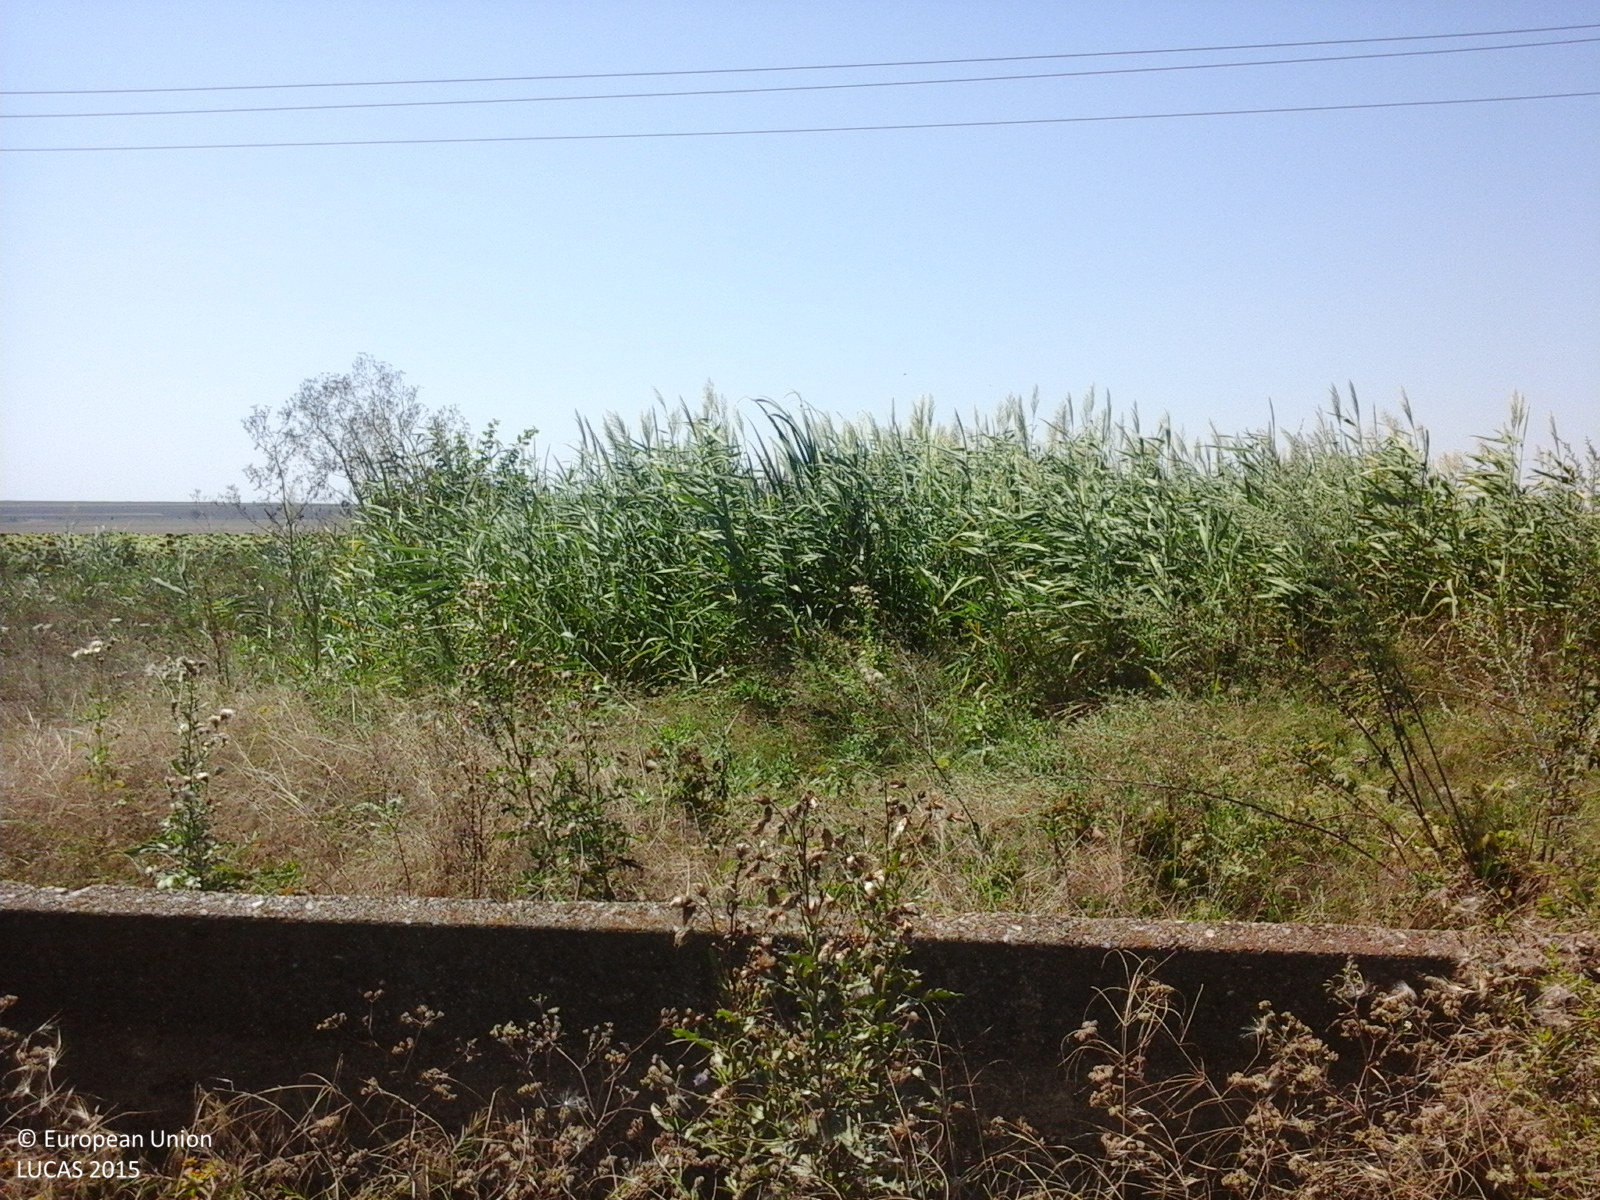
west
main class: Cropland
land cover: Sunflower
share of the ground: > 75 %
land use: Agriculture (excluding fallow land and kitchen gardens)
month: August
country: RO
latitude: 44.3190
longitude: 28.5673
